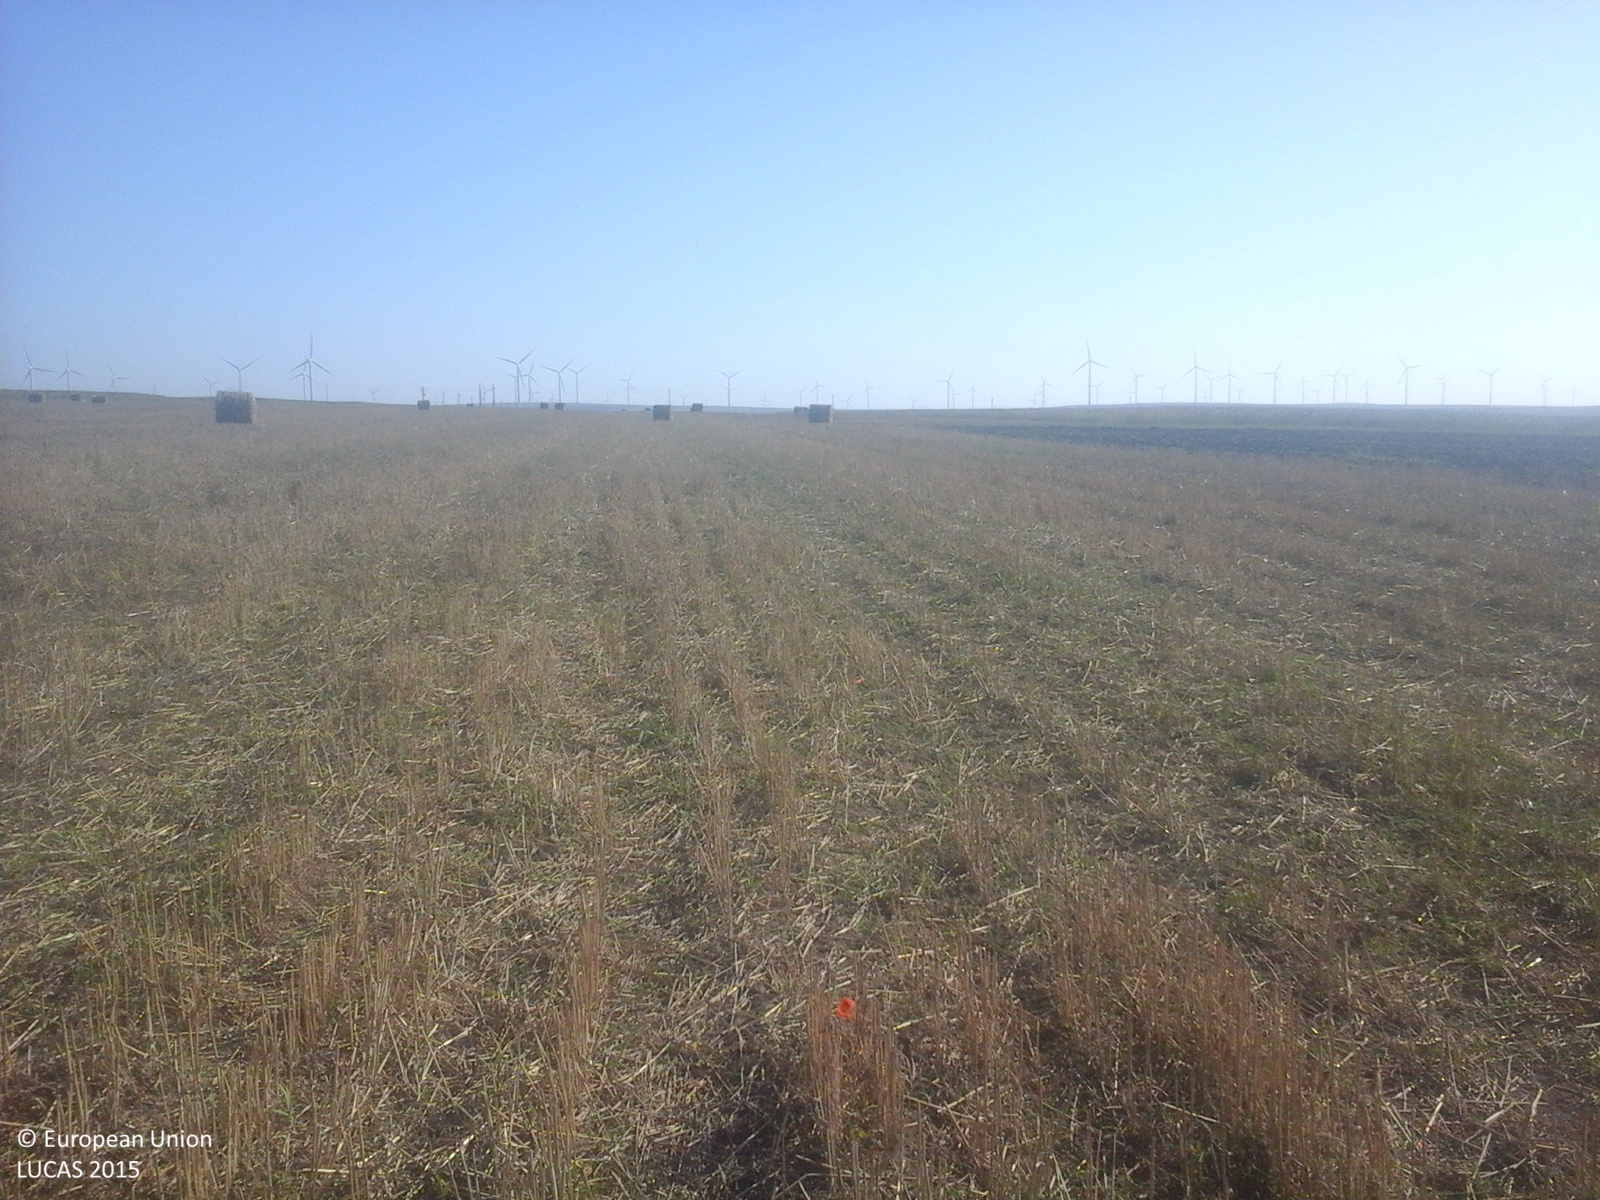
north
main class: Cropland
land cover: Common wheat
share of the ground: > 75 %
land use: Agriculture (excluding fallow land and kitchen gardens)
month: August
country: RO
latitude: 44.5067
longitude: 28.4486
